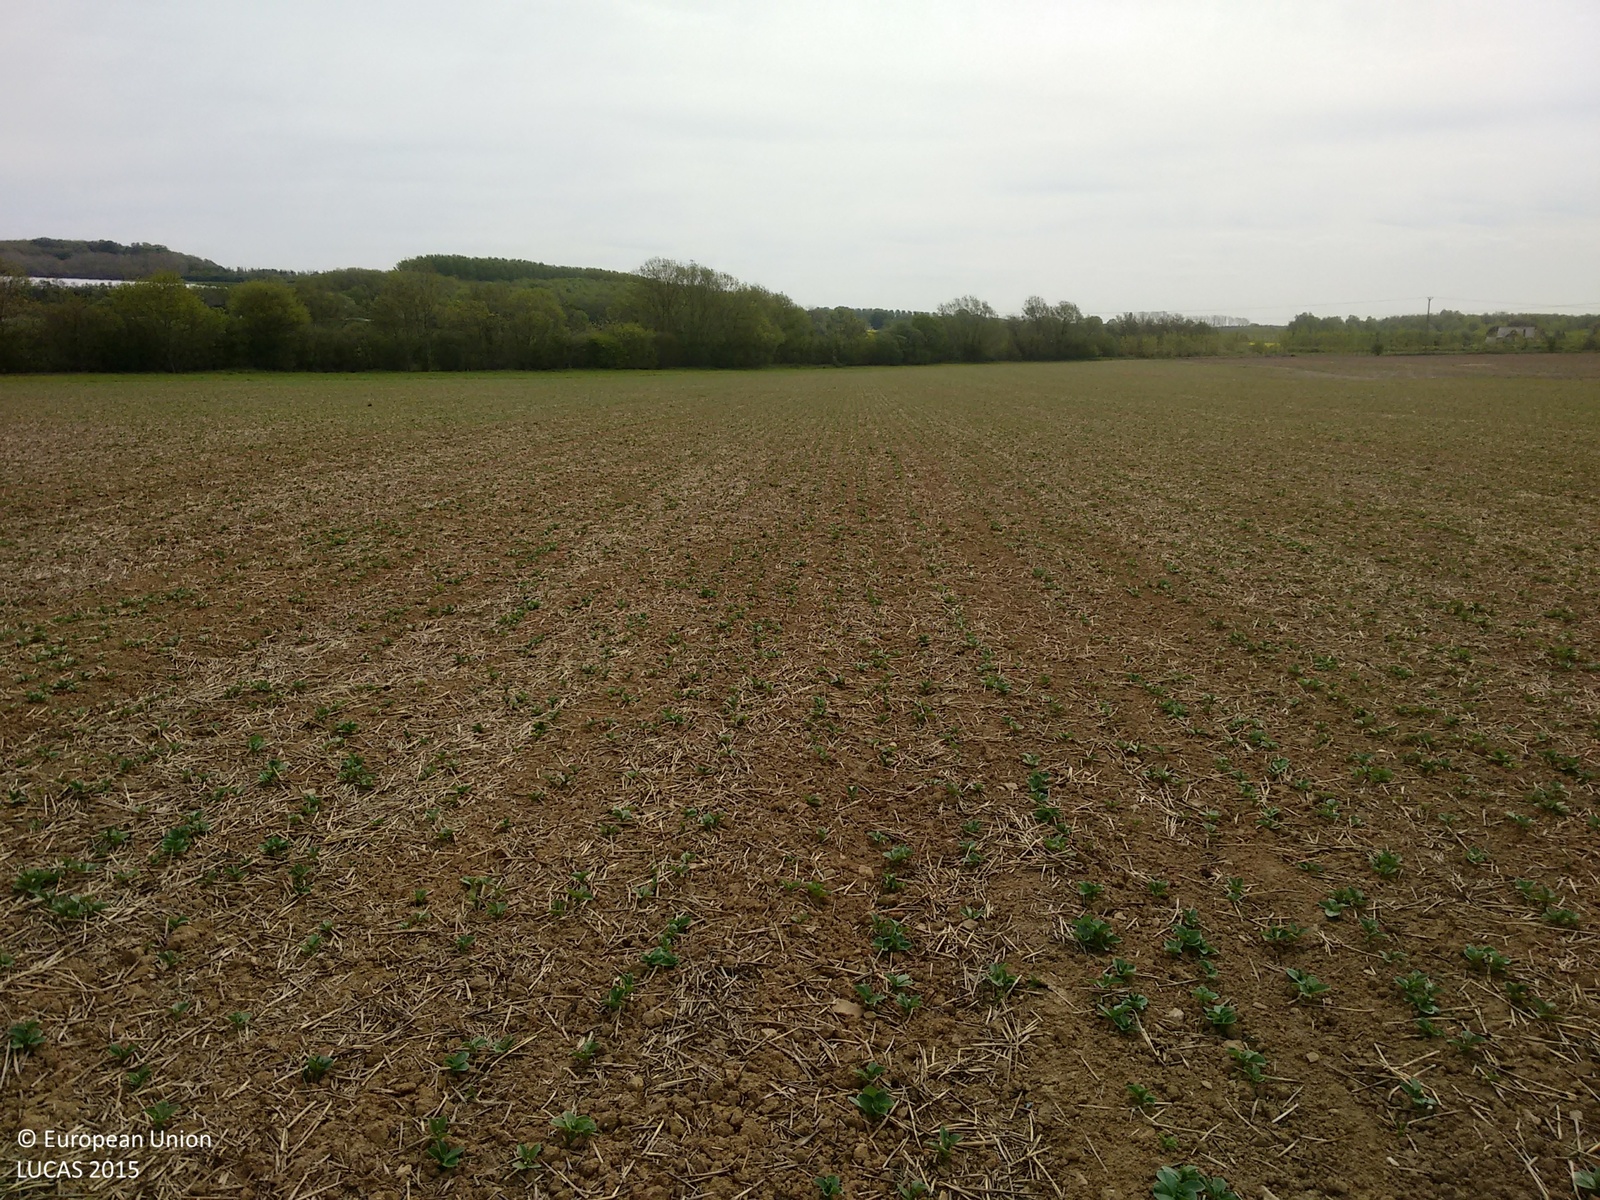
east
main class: Cropland
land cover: Dry pulses
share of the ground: 10 - 25 %
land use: Agriculture (excluding fallow land and kitchen gardens)
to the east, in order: Dry pulses; Grassland without tree/shrub cover; Tracks; Grassland without tree/shrub cover; Managed hedges; Ditches and canals; Fences; Shruby margins; Common wheat; Shruby margins; Managed hedges; Fences; Grassland without tree/shrub cover
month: May
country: GB
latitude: 51.2418
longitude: 0.3591
